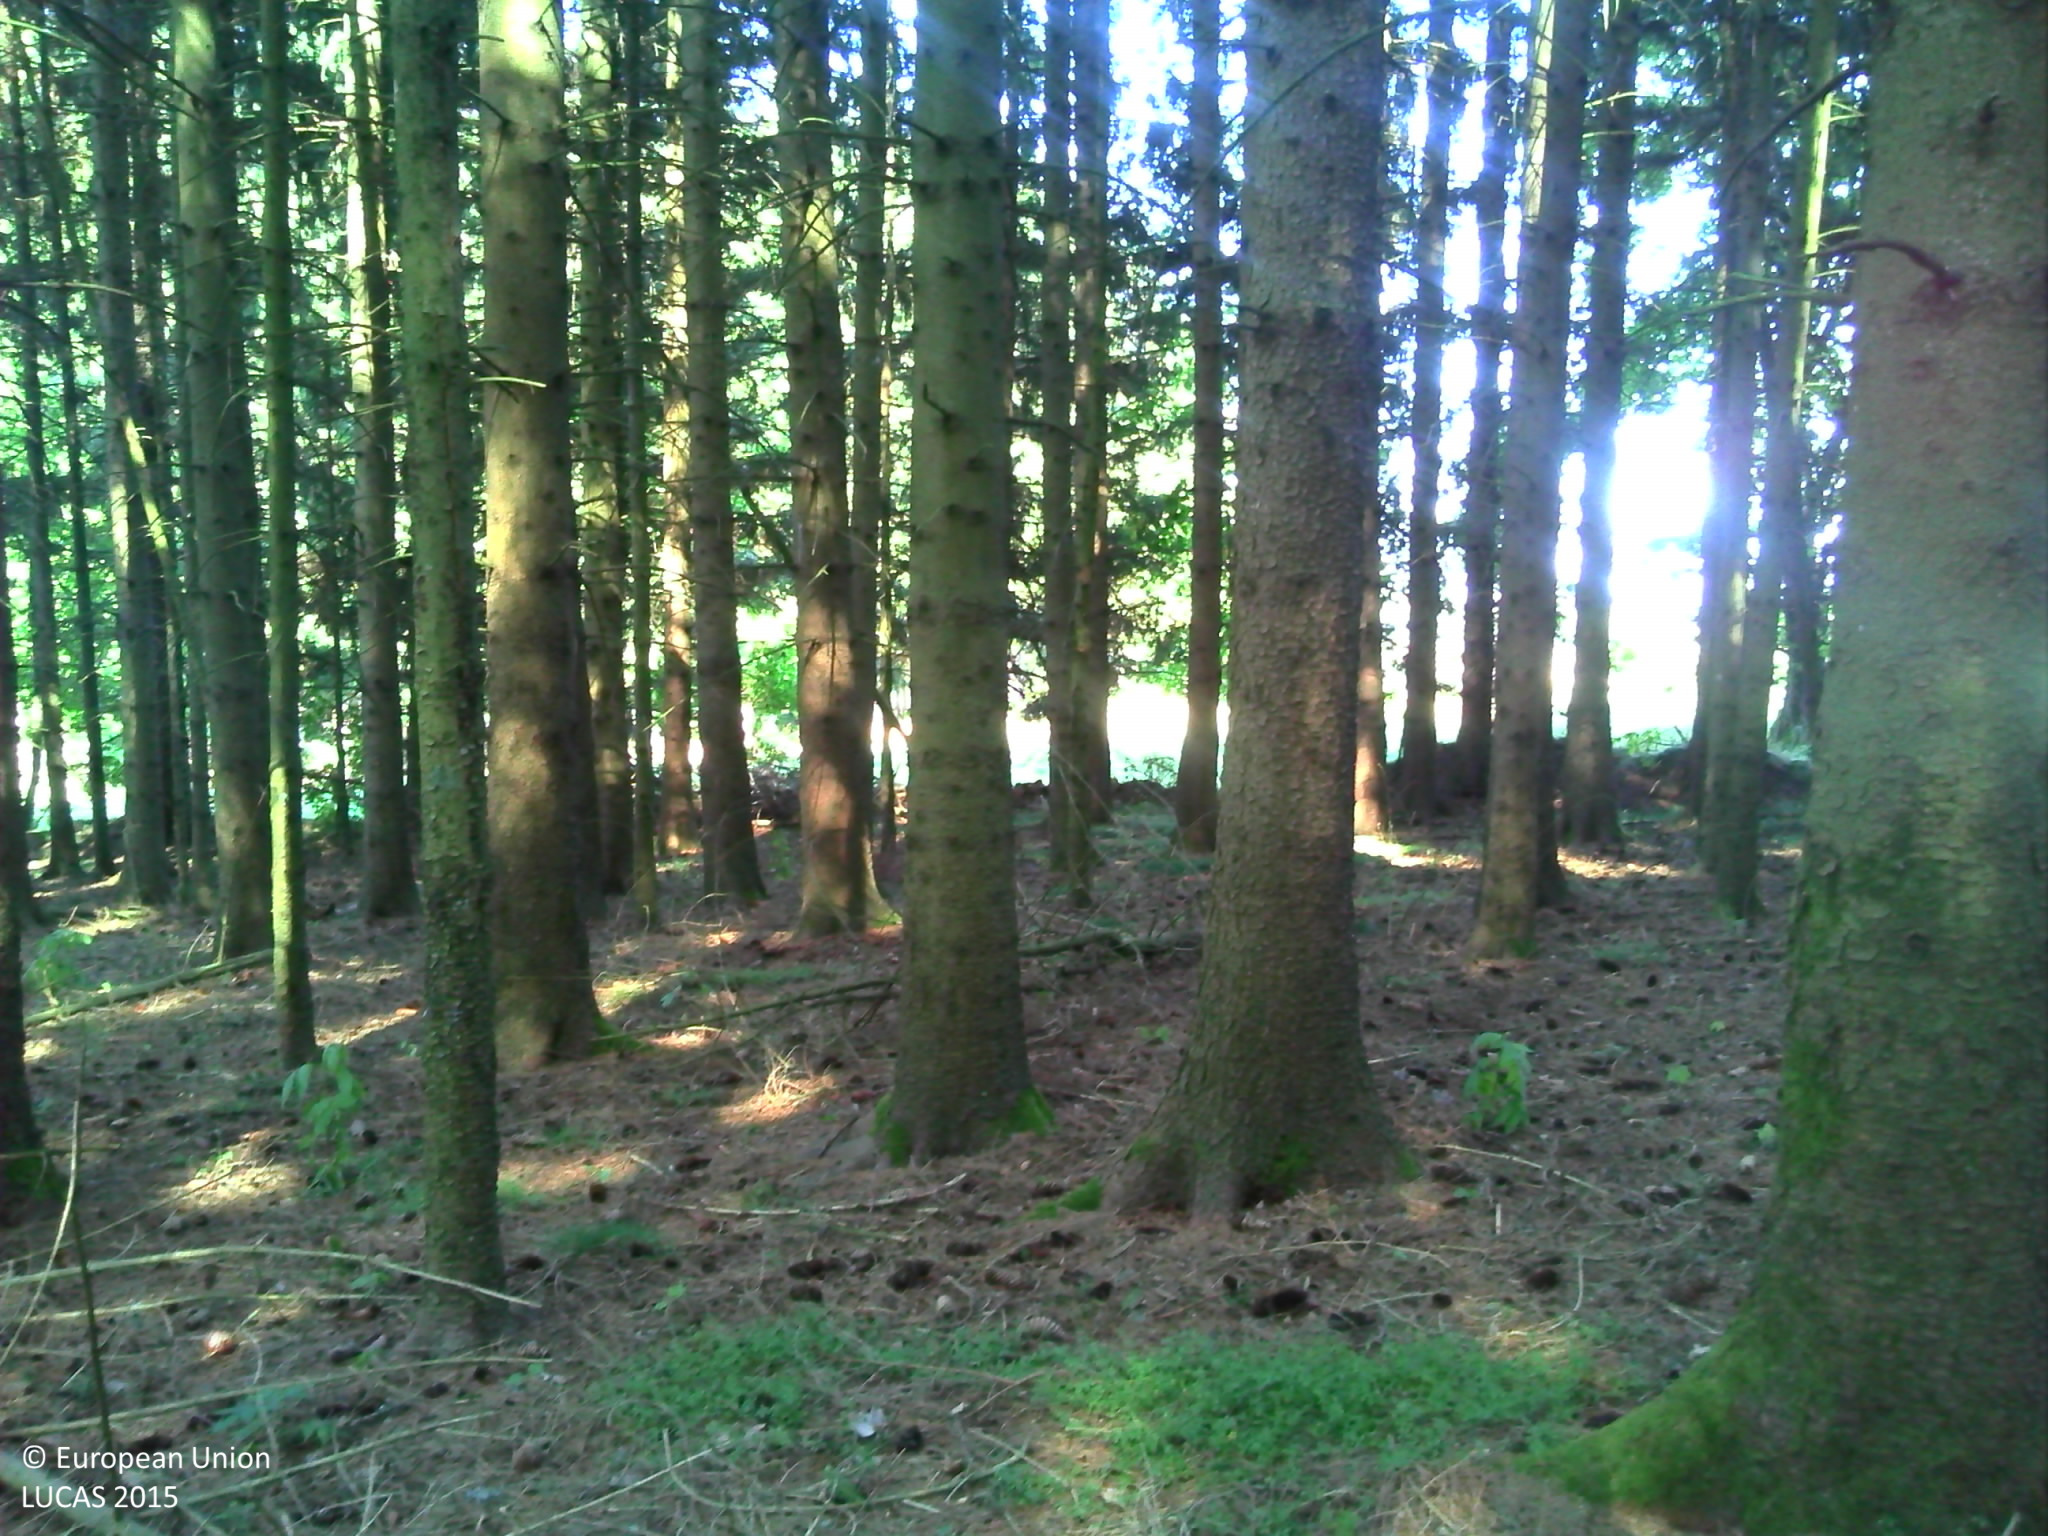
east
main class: Woodland
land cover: Spruce dominated coniferous woodland
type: exotic forest
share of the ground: > 75 %
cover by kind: coniferous forest trees 95 %, unconsolidated bare surface 5 %
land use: Forestry
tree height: > 5 m
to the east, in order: Spruce dominated coniferous woodland; Fences; Grassland without tree/shrub cover; Fences; Grassland without tree/shrub cover; Fences; Abandoned hedges; Tracks; Abandoned hedges; Fences; Grassland without tree/shrub cover
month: August
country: FR
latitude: 45.6598
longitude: 2.8507
